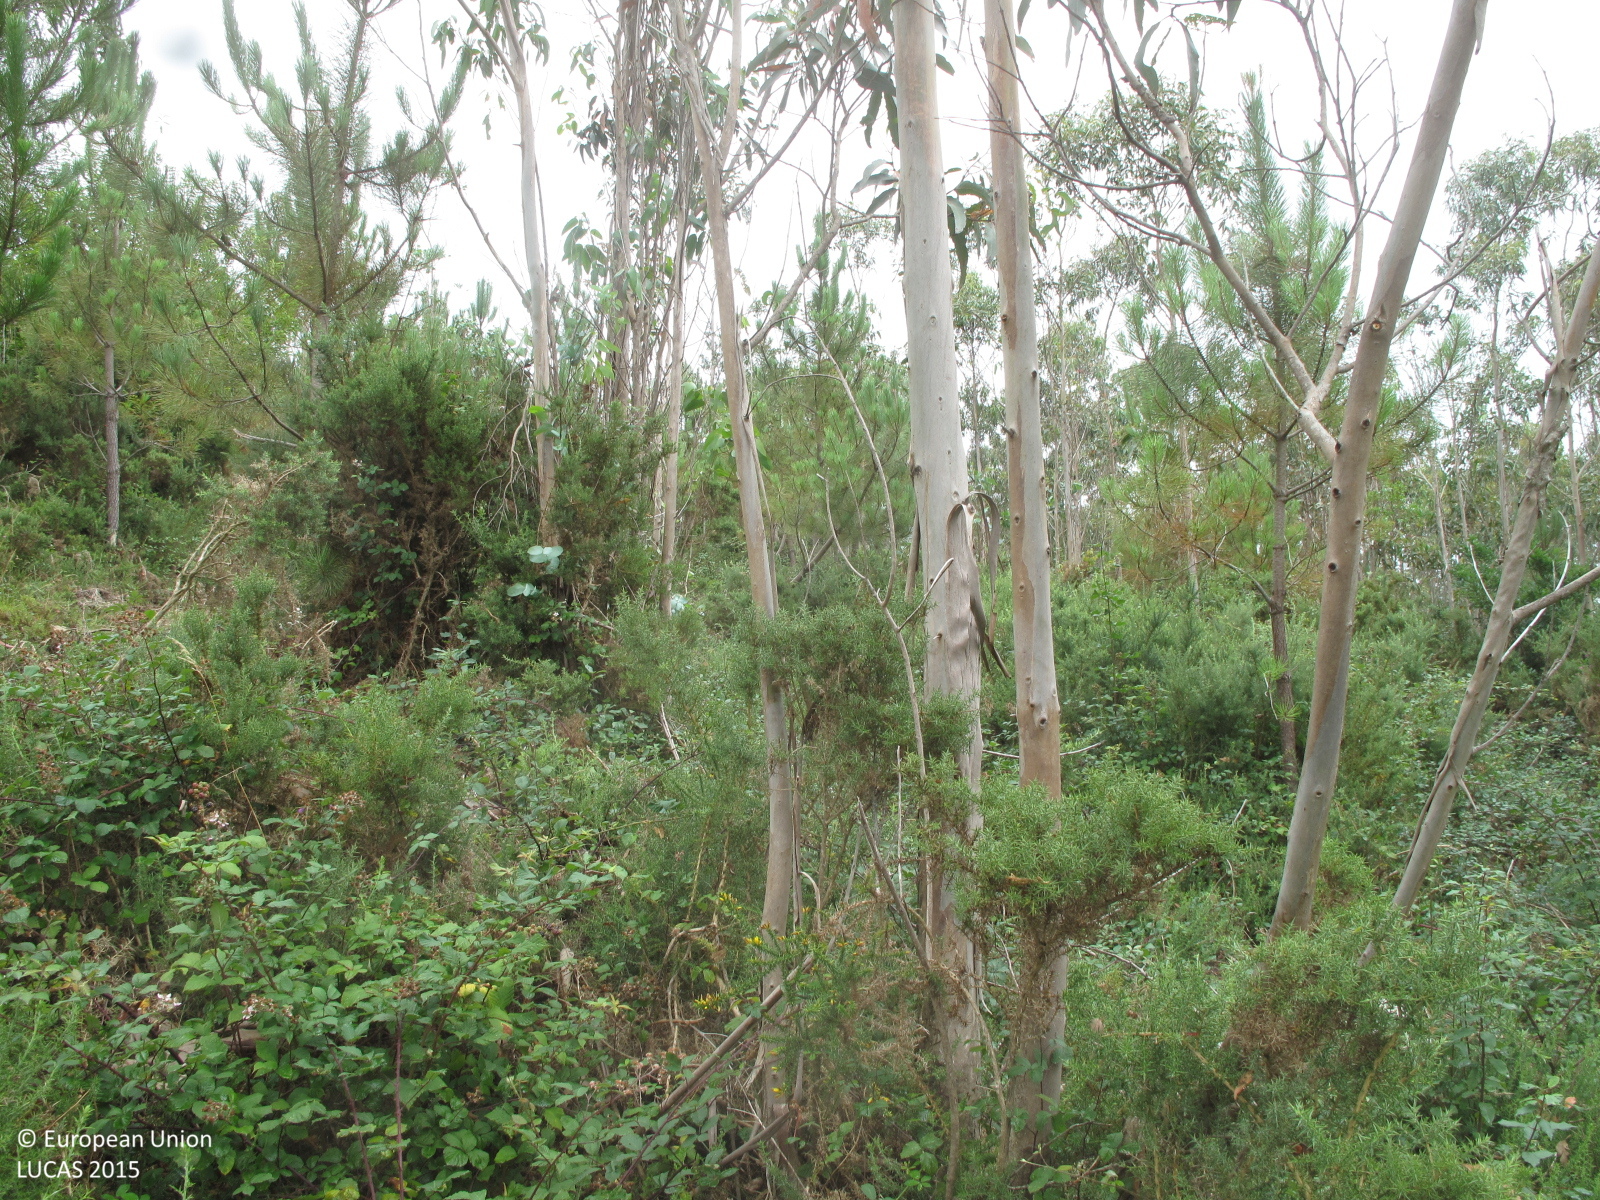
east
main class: Woodland
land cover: Other mixed woodland
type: exotic forest
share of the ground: 50 - 75 %
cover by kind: shrubs 40 %, broadleaved forest trees 30 %, coniferous forest trees 20 %, herbaceous plants 10 %
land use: Forestry
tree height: > 5 m
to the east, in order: Other mixed woodland; Tracks; Pine dominated mixed woodland; Shrubland with sparse tree cover; Shrubland without tree cover
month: July
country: ES
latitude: 42.9859
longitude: -9.1726
